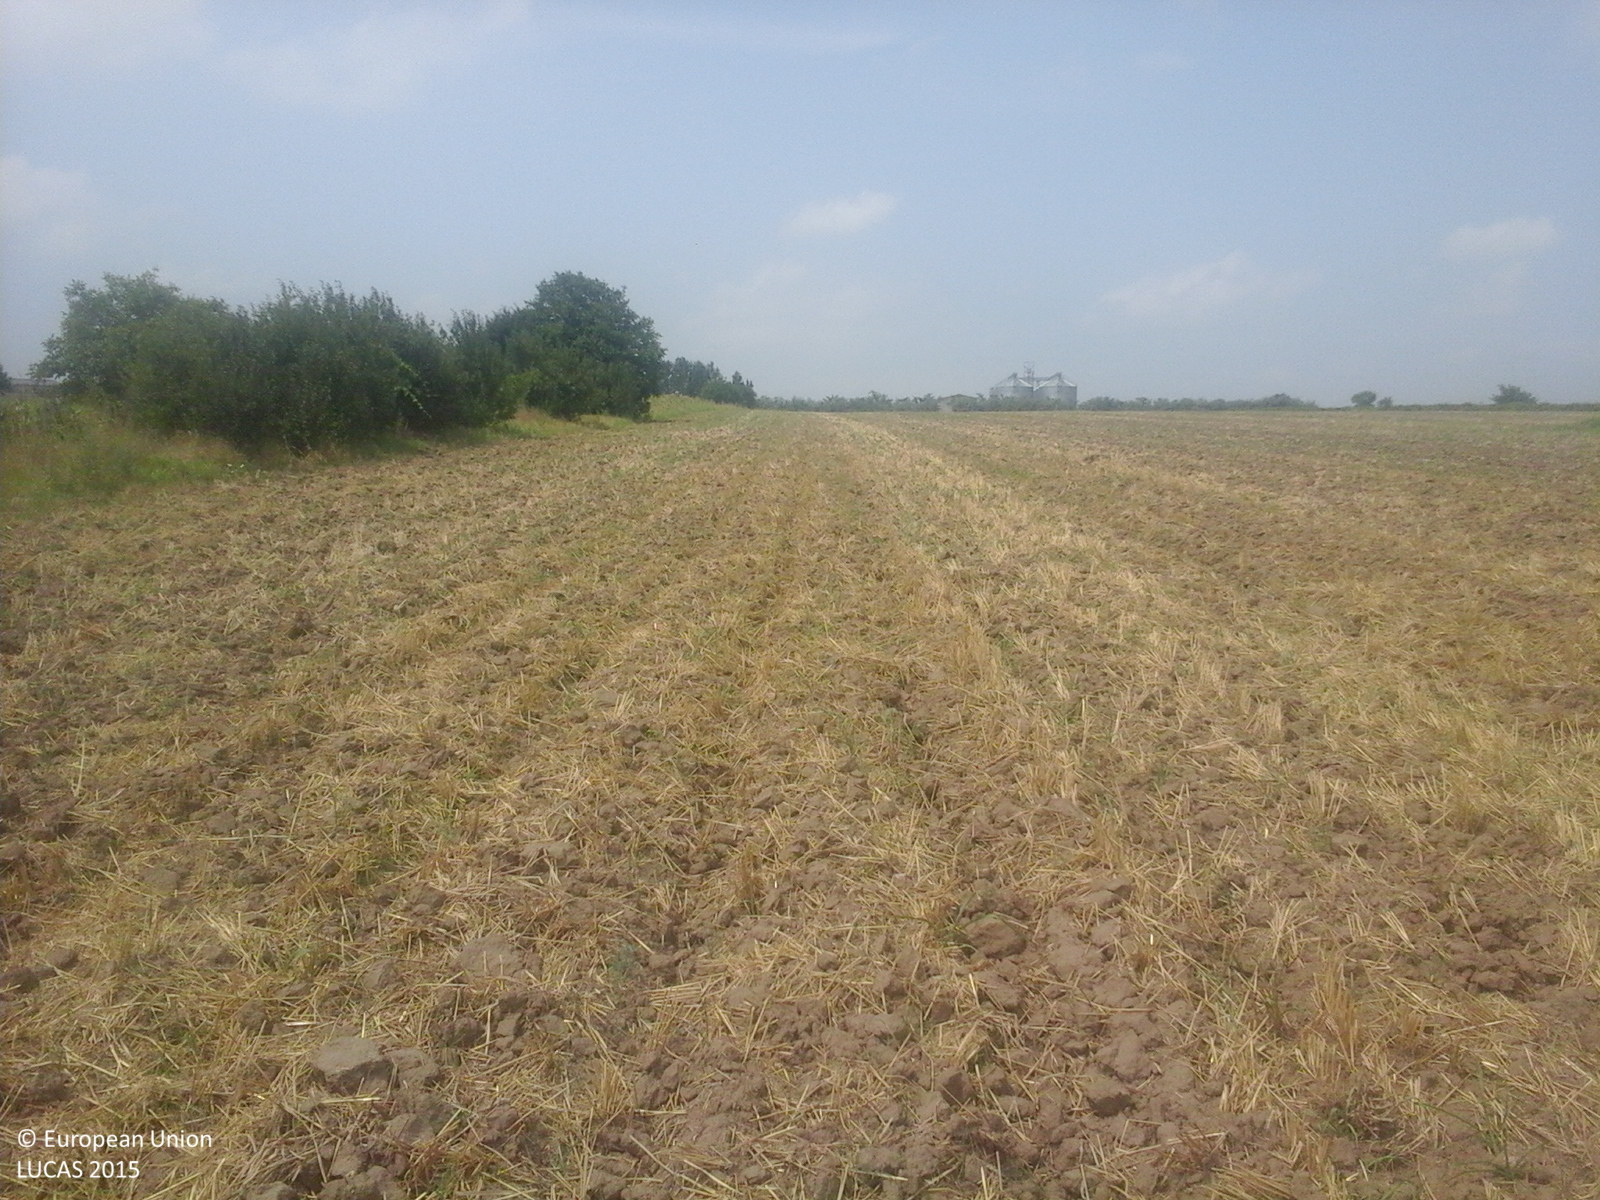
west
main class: Cropland
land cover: Durum wheat
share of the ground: 10 - 25 %
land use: Agriculture (excluding fallow land and kitchen gardens)
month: July
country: RO
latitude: 45.2953
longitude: 28.2698
